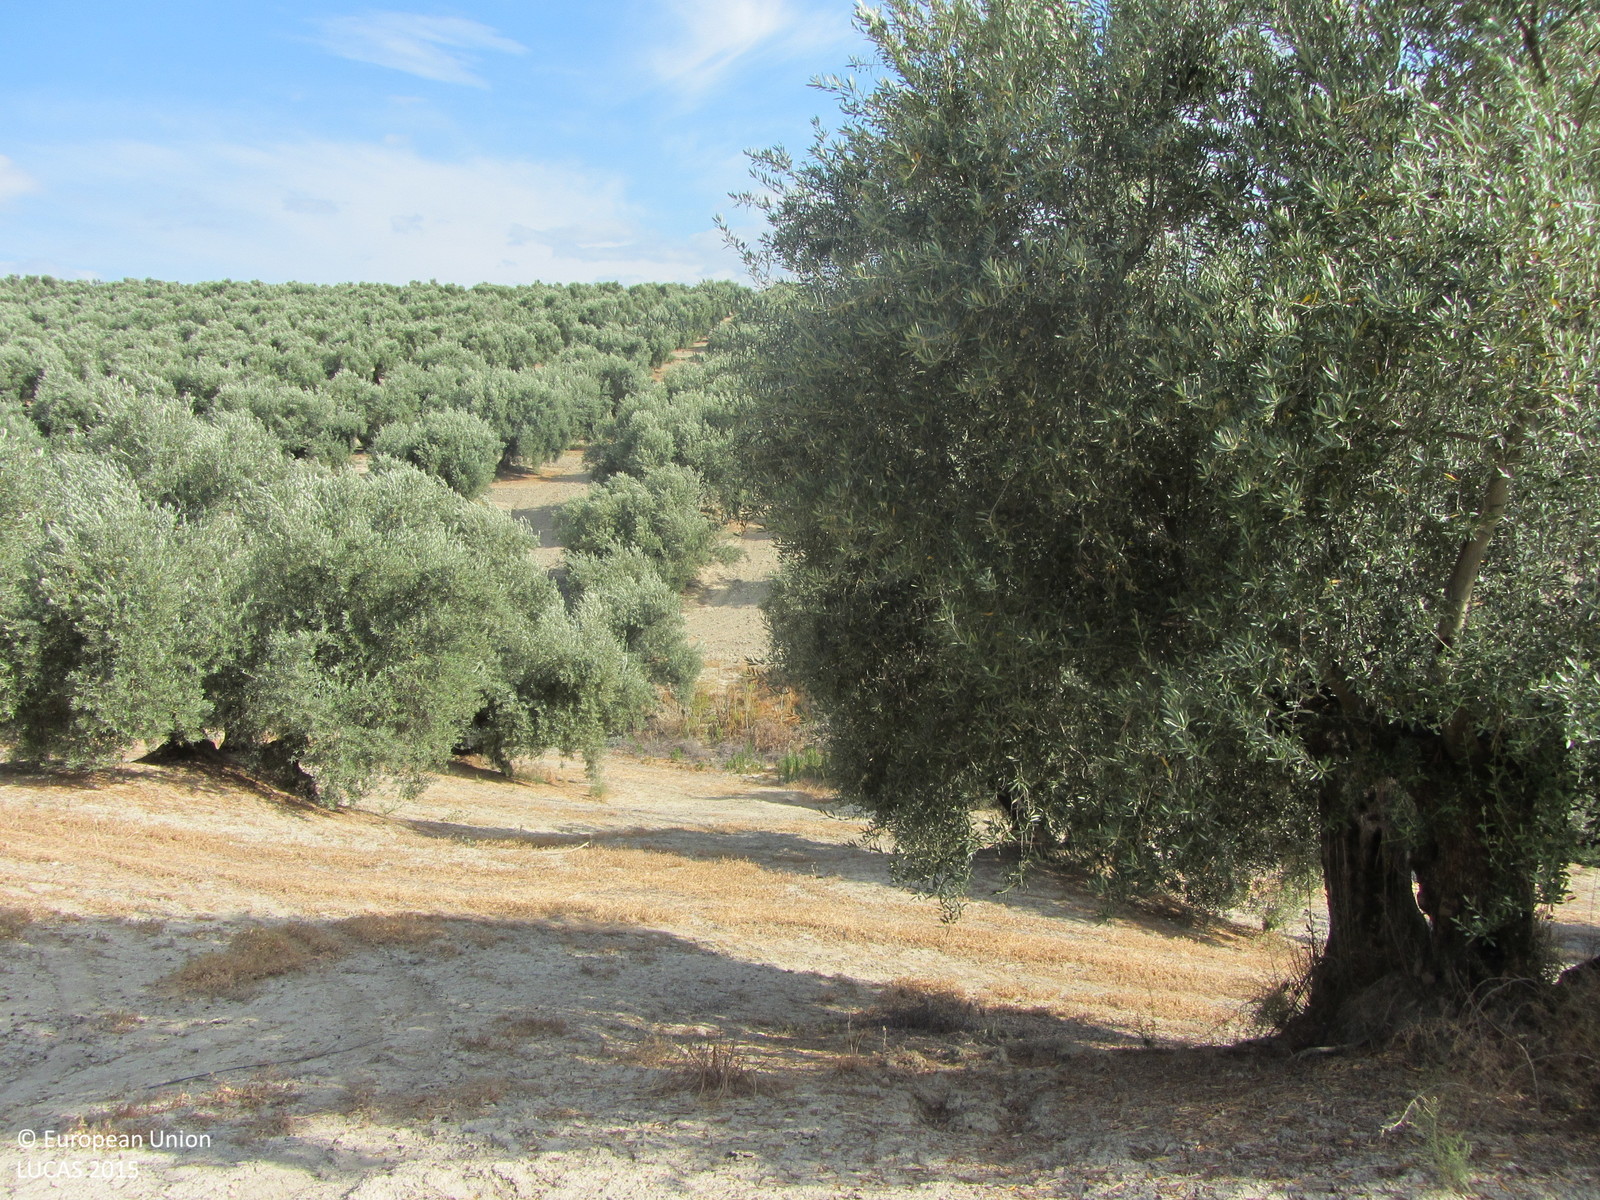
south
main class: Cropland
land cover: Olive groves
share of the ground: 50 - 75 %
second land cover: Other bare soil
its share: > 75 %
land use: Agriculture (excluding fallow land and kitchen gardens)
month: June
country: ES
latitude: 37.9703
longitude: -3.2599
